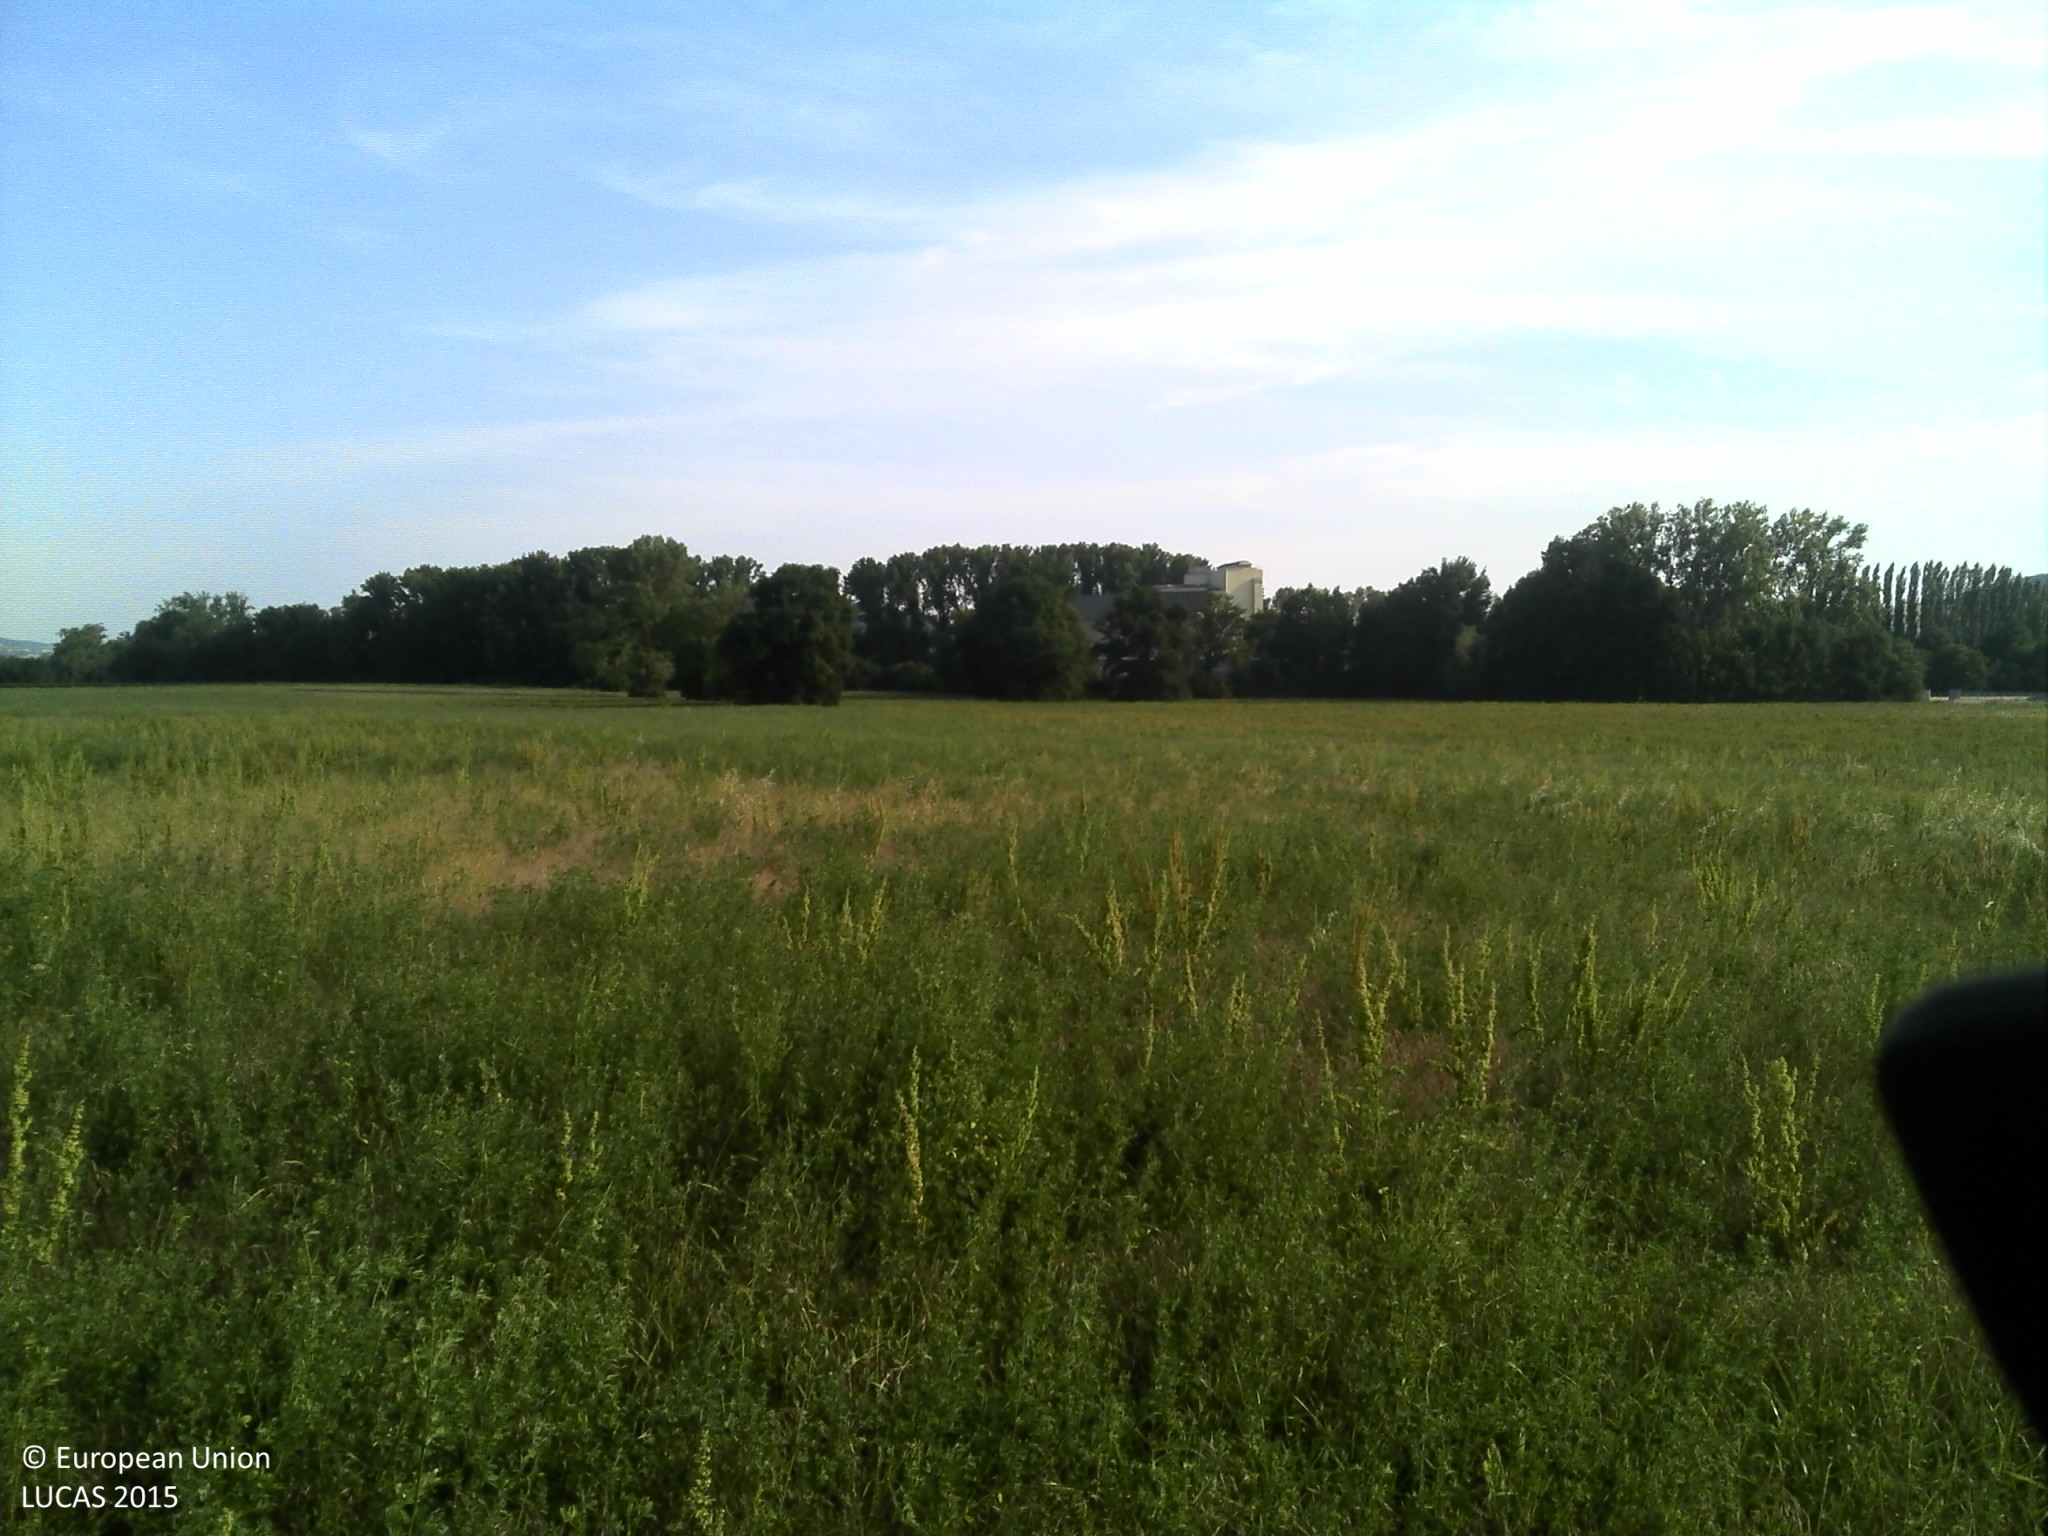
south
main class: Grassland
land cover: Spontaneously vegetated surfaces
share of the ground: > 75 %
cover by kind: herbaceous plants 100 %
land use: Agriculture (excluding fallow land and kitchen gardens)
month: July
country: FR
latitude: 45.7812
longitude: 3.3251
